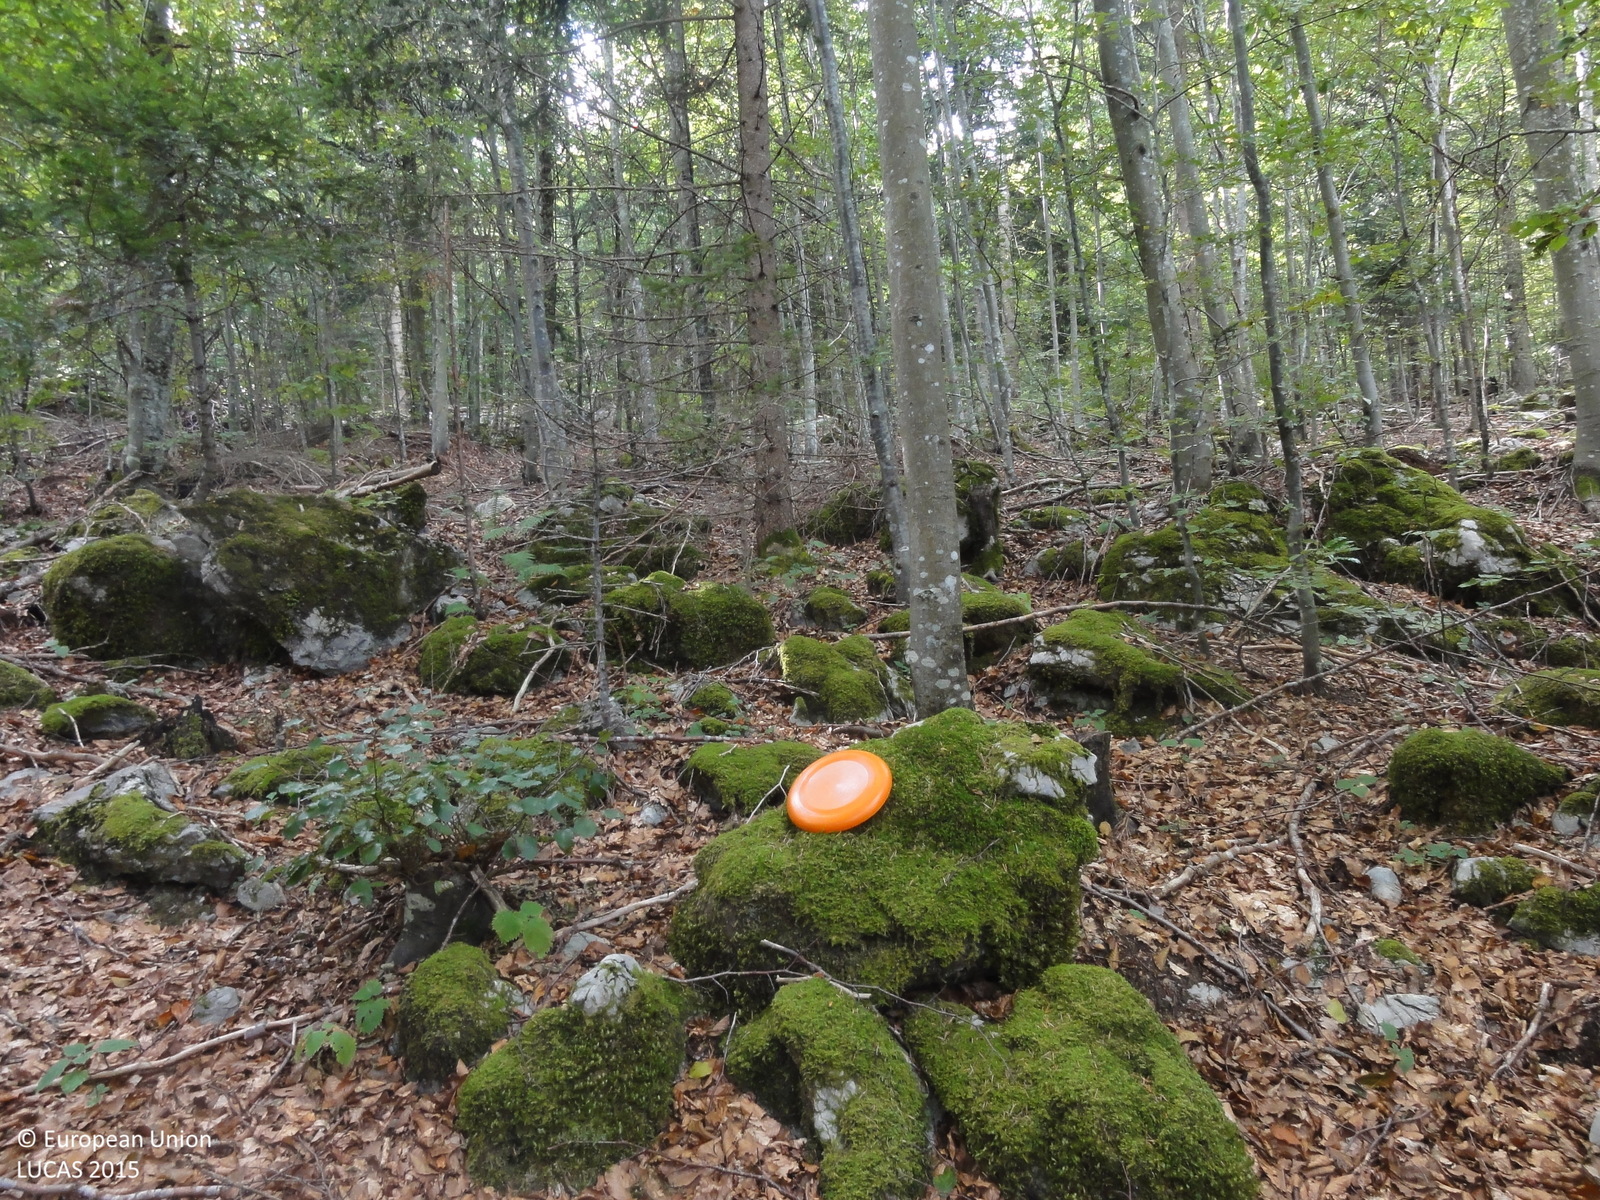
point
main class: Woodland
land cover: Spruce dominated mixed woodland
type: mountainous beech forest
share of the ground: > 75 %
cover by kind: broadleaved forest trees 60 %, coniferous forest trees 40 %
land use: Forestry
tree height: > 5 m
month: September
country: SI
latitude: 45.6729
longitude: 15.0410
